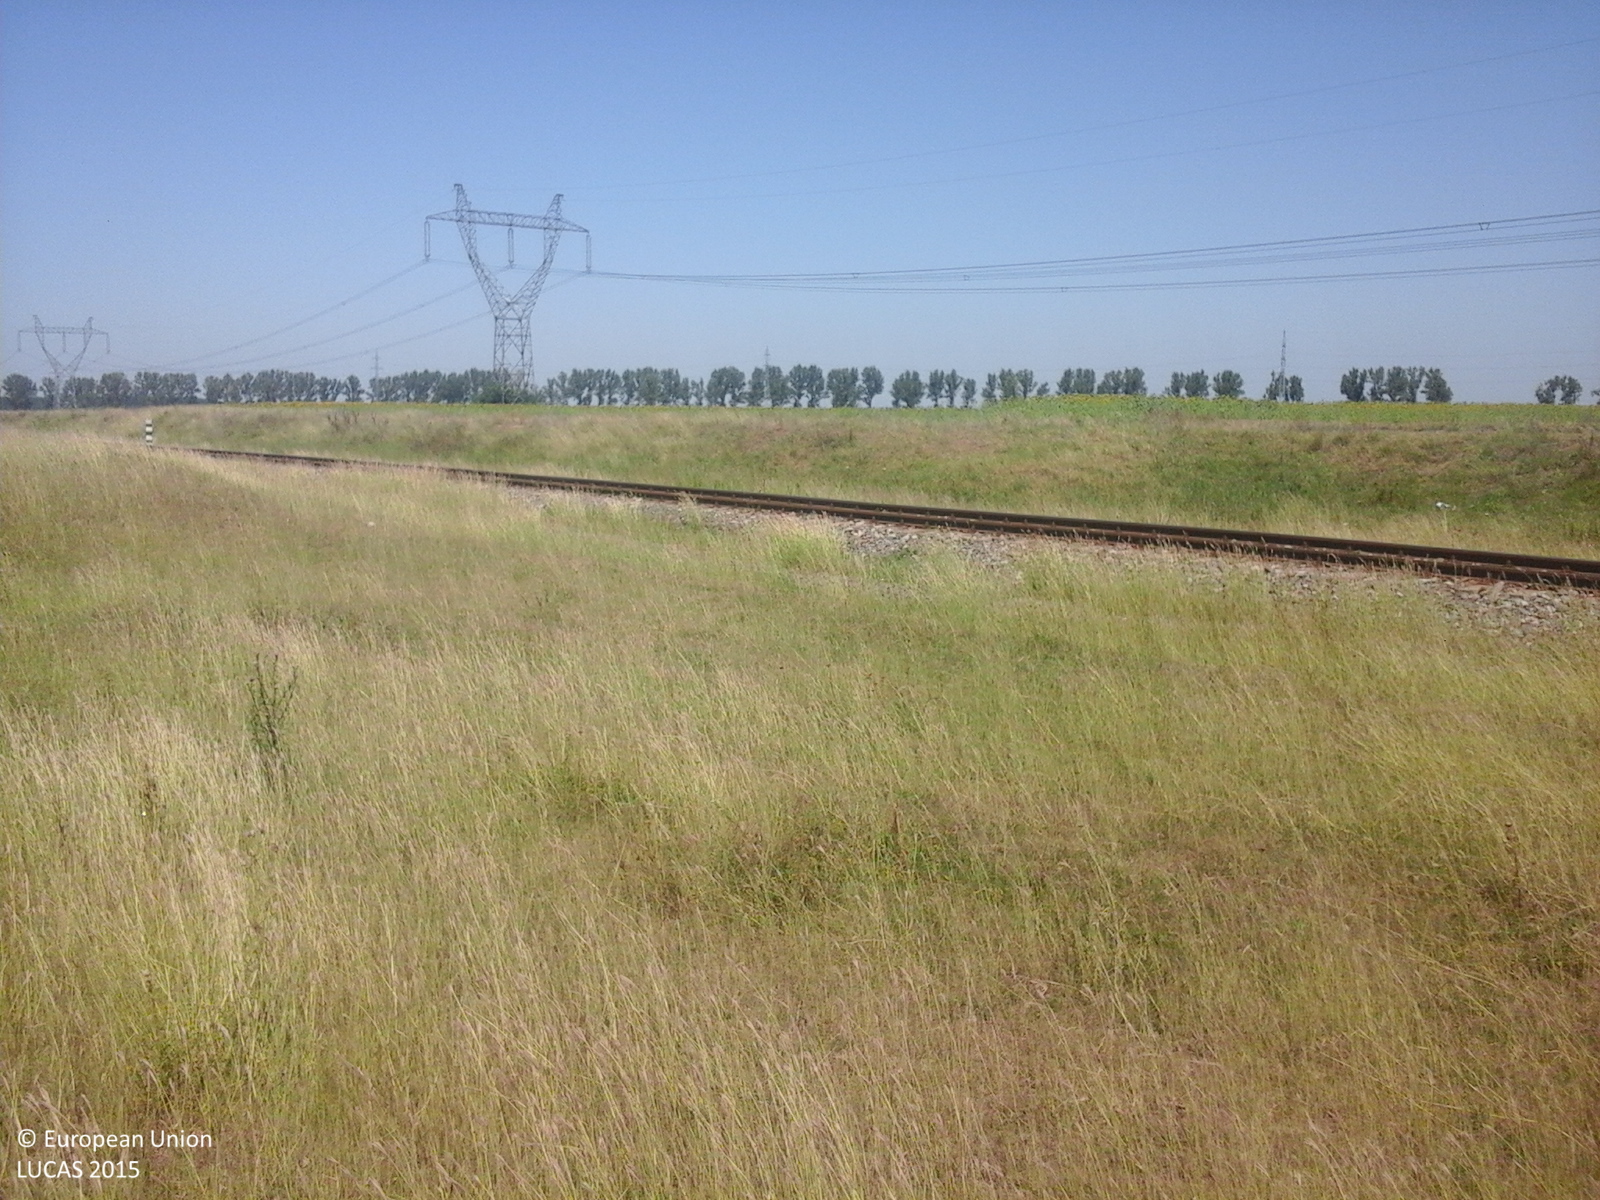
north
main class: Grassland
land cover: Spontaneously vegetated surfaces
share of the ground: > 75 %
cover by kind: herbaceous plants 100 %
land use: Fallow land
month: July
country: RO
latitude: 44.2196
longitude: 26.5746
